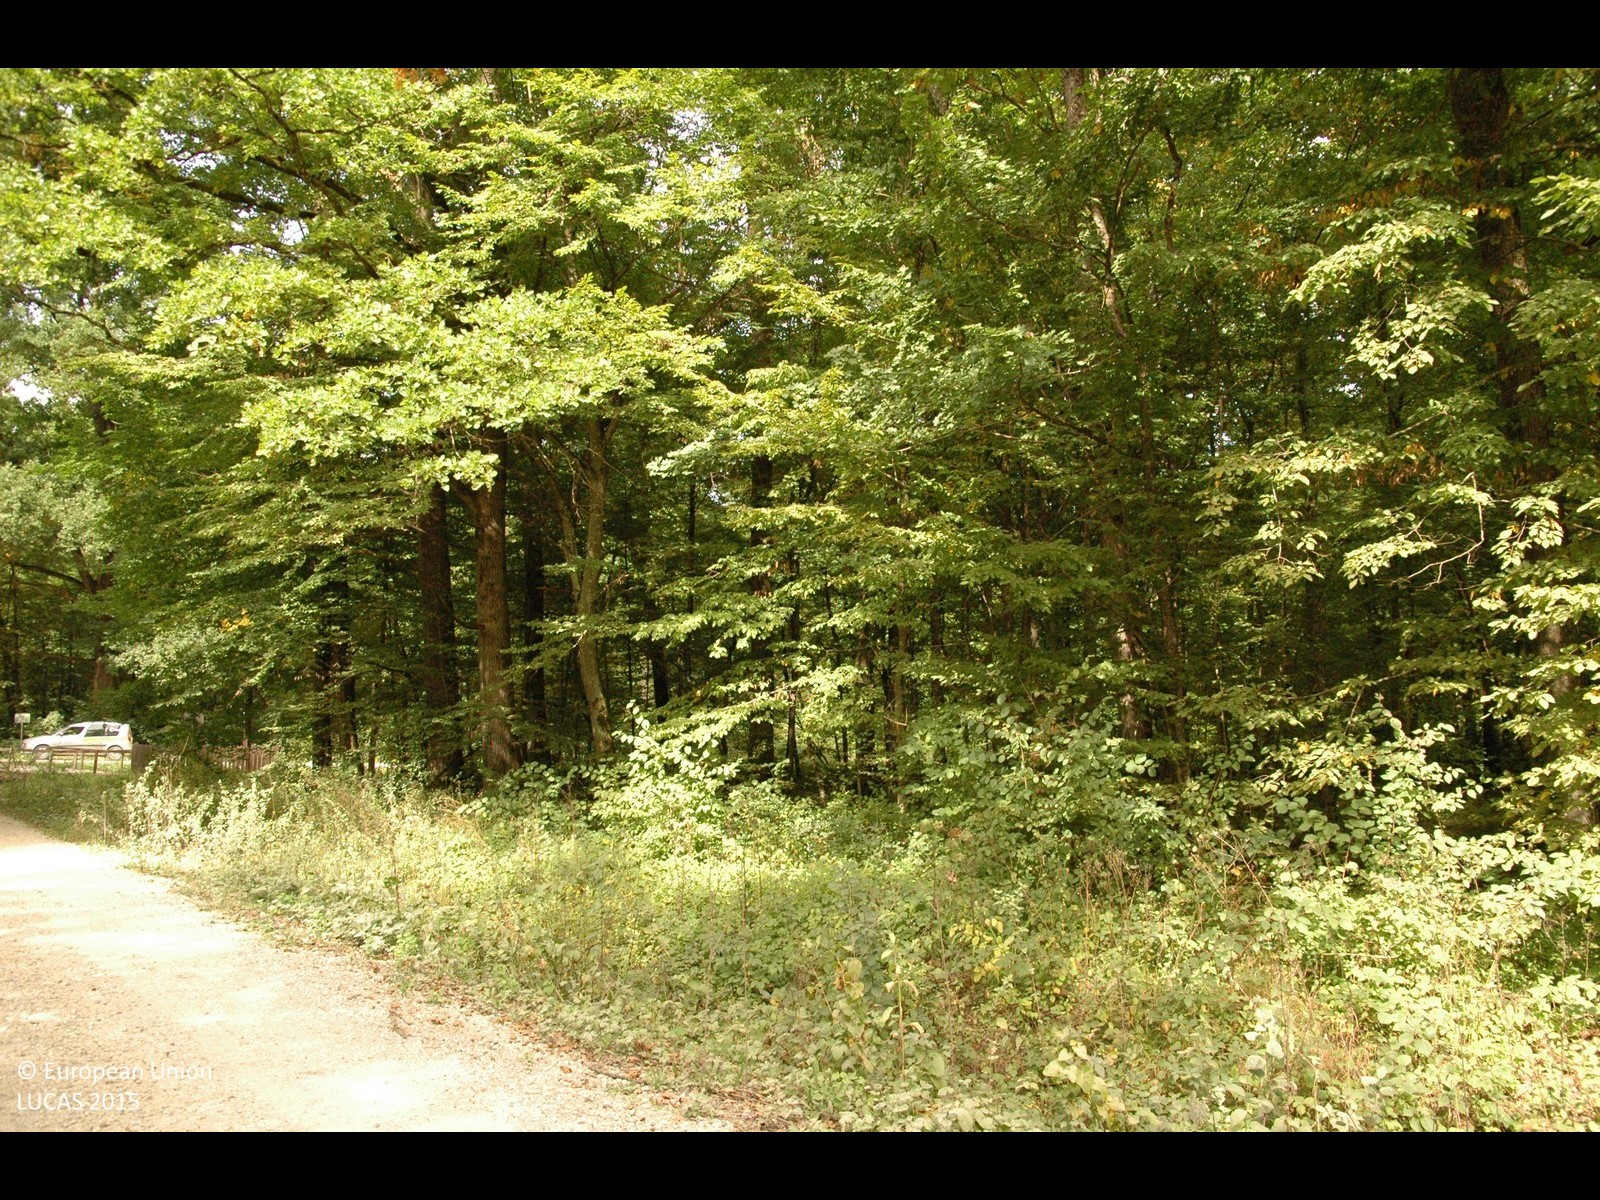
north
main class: Woodland
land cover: Broadleaved woodland
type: mesophytic deciduous forest
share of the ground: > 75 %
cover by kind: broadleaved forest trees 100 %
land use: Forestry
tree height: > 5 m
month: September
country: HR
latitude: 45.6088
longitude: 16.2424
